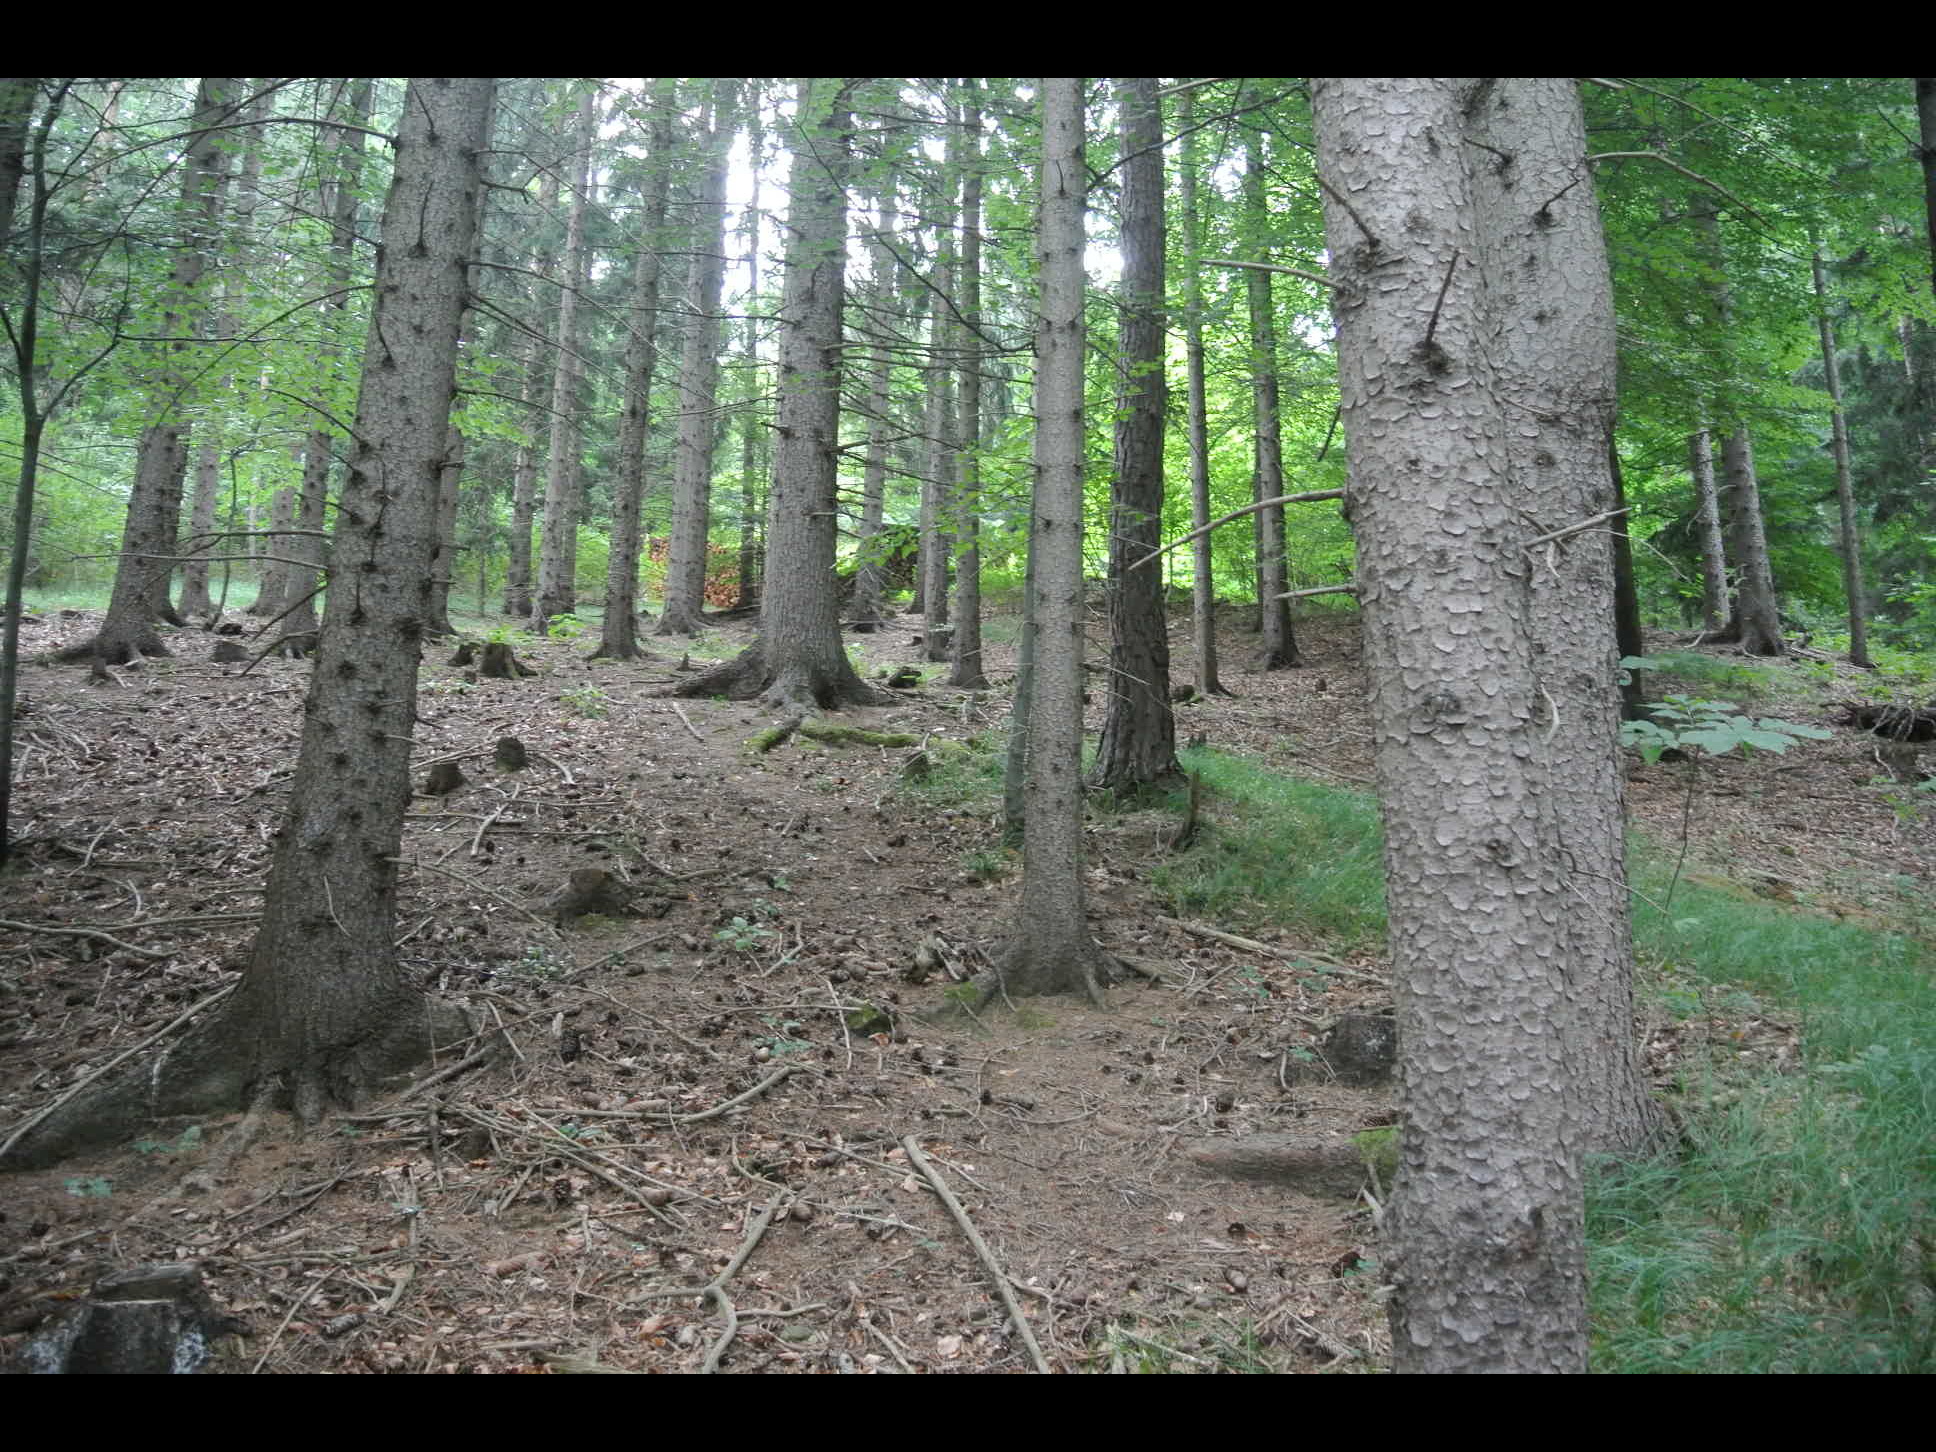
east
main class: Woodland
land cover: Other mixed woodland
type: alpine coniferous forest
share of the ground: > 75 %
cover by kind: coniferous forest trees 60 %, broadleaved forest trees 40 %
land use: Forestry
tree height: > 5 m
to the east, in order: Other mixed woodland; Rivers and streams; Other mixed woodland; Grassland without tree/shrub cover; Maize; Barley; Common wheat; Broadleaved woodland
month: July
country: AT
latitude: 47.6732
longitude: 16.1431
